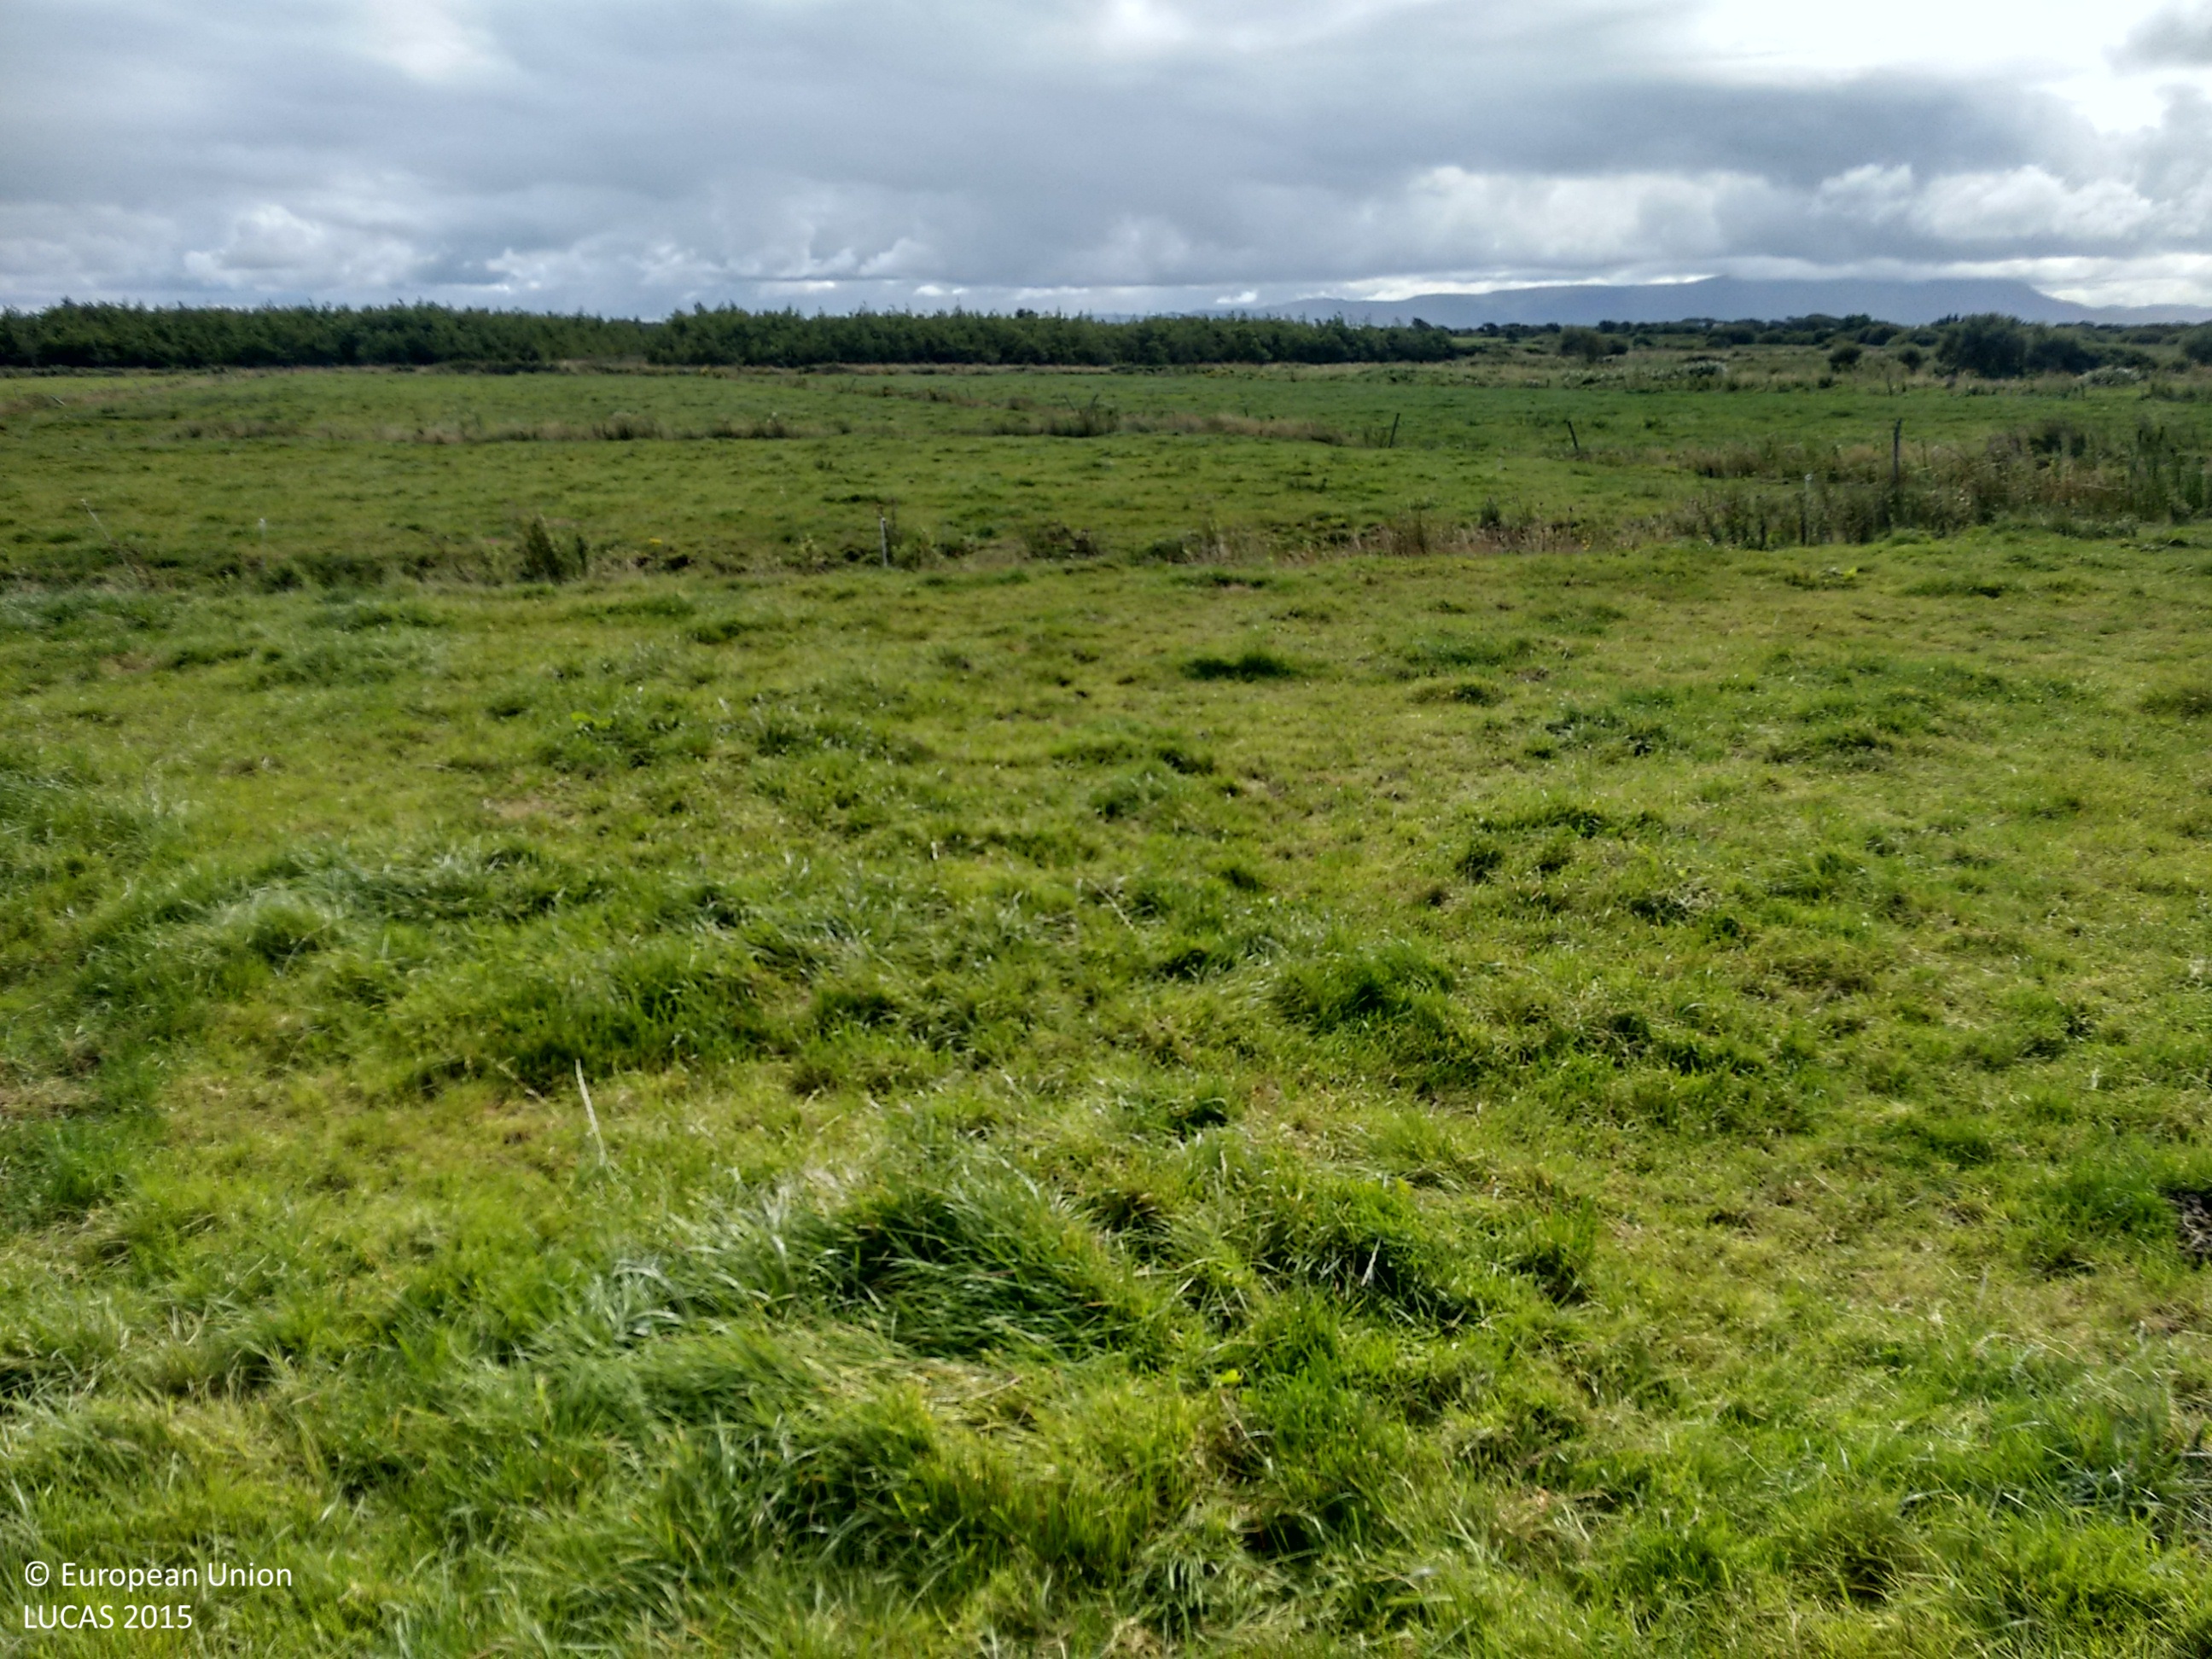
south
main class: Grassland
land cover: Grassland without tree/shrub cover
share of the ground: > 75 %
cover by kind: herbaceous plants 100 %
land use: Agriculture (excluding fallow land and kitchen gardens)
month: September
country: IE
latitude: 52.3950
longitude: -9.7752
